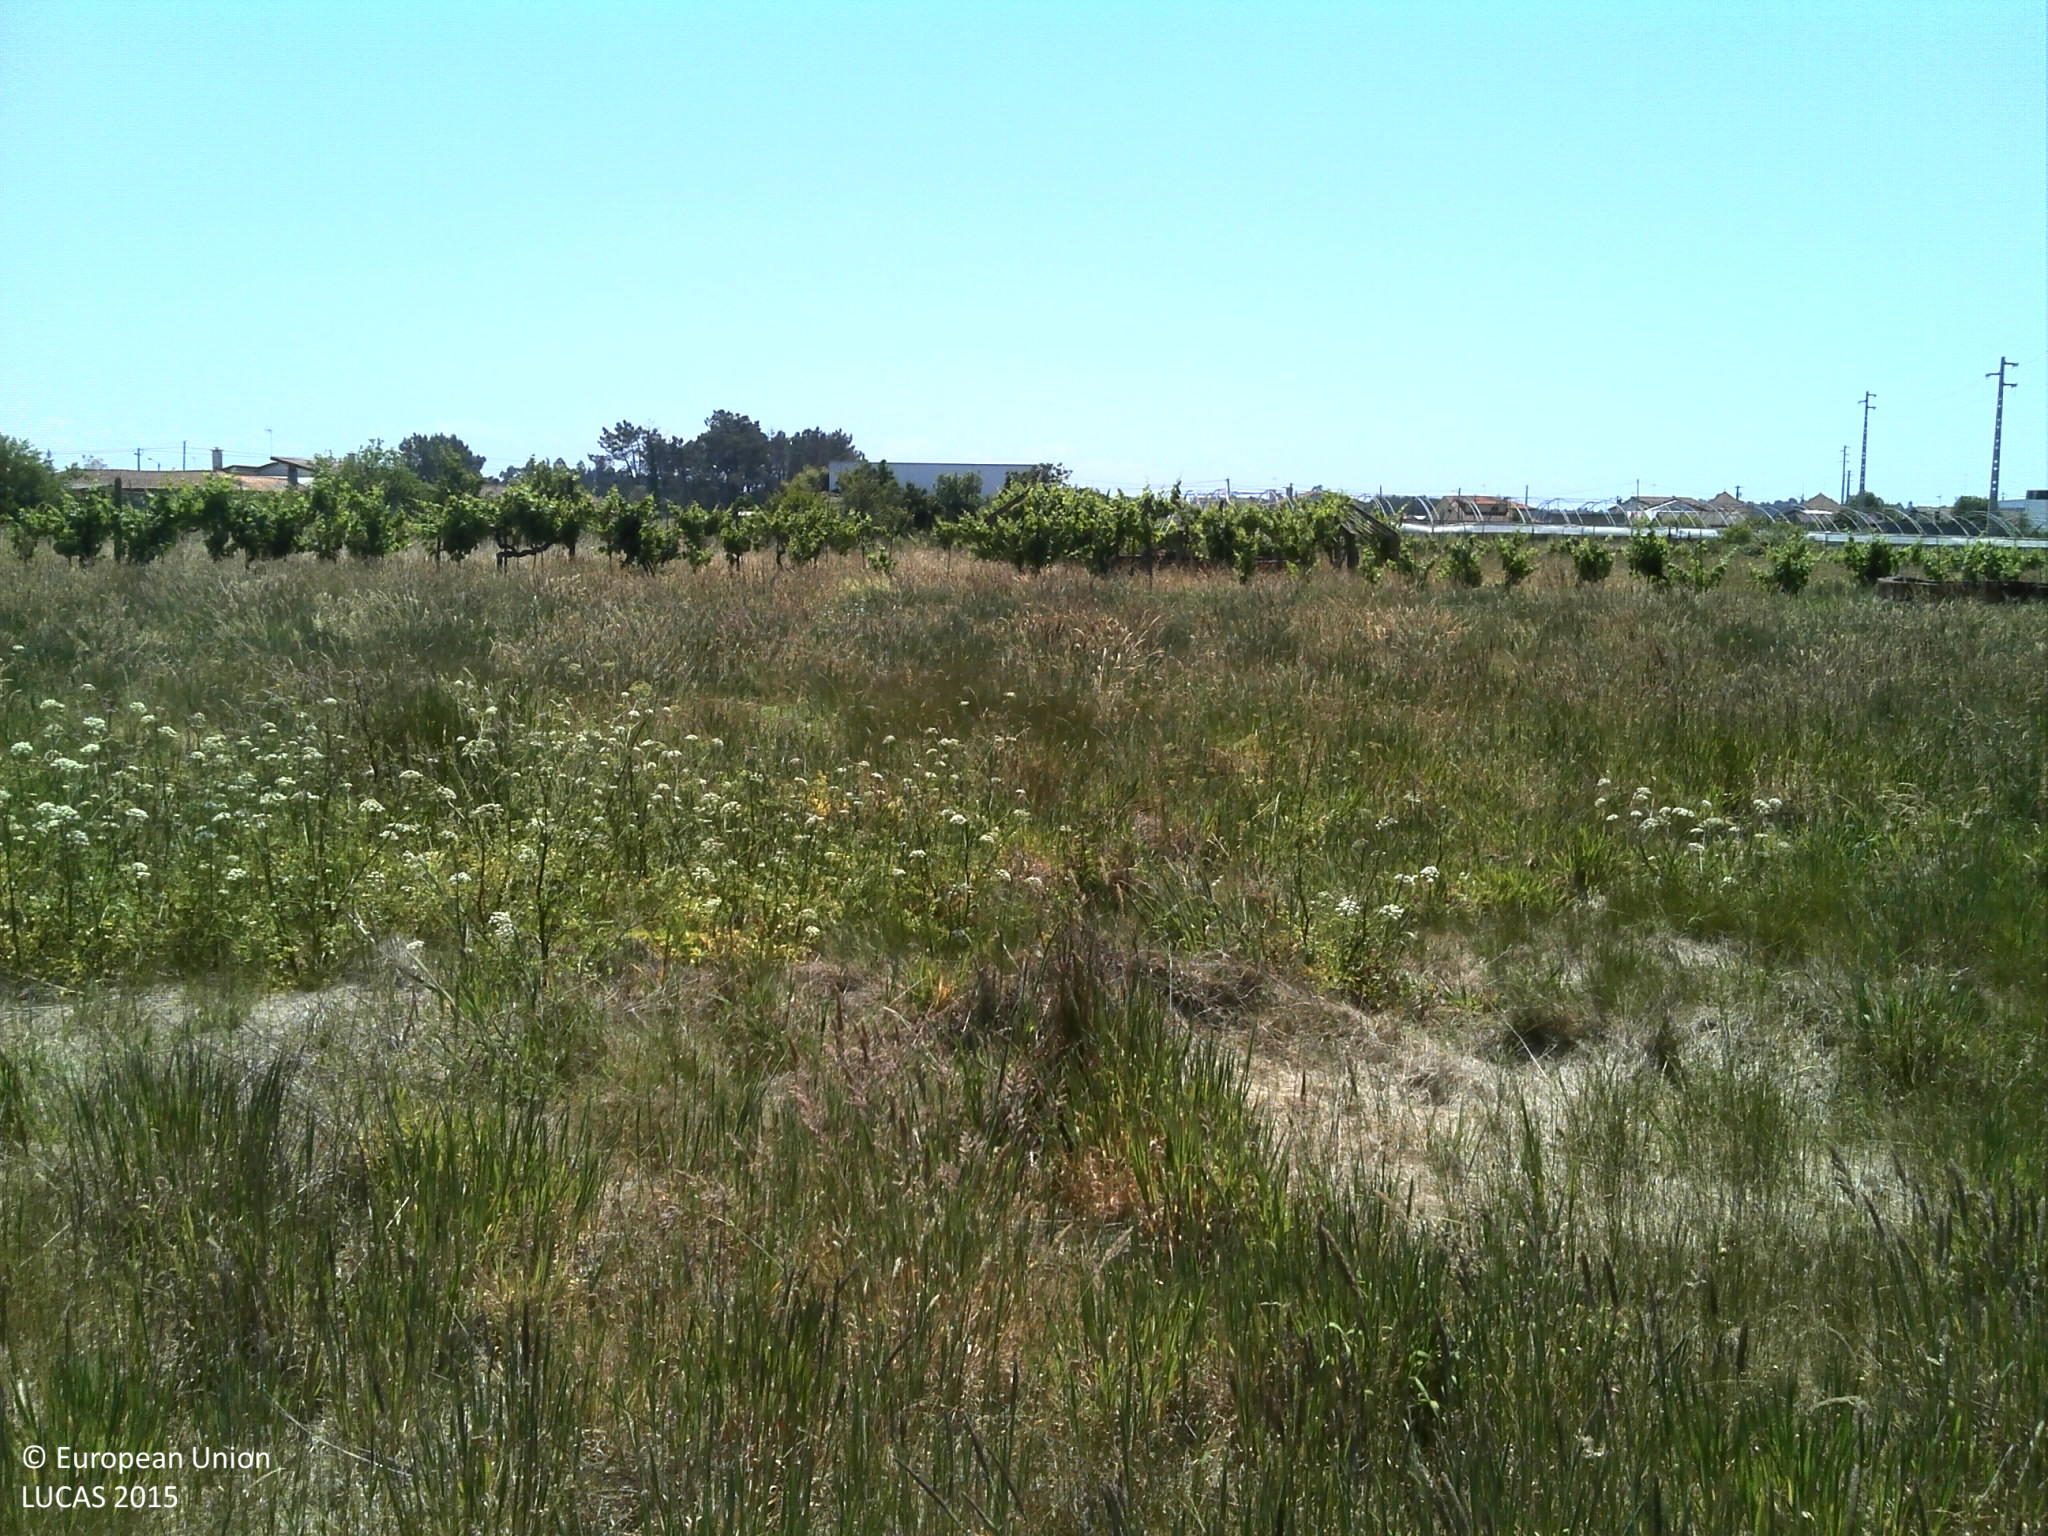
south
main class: Grassland
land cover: Grassland without tree/shrub cover
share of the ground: 50 - 75 %
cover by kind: herbaceous plants 75 %, unconsolidated bare surface 25 %
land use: Agriculture (excluding fallow land and kitchen gardens)
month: May
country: PT
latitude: 40.4432
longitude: -8.6391
